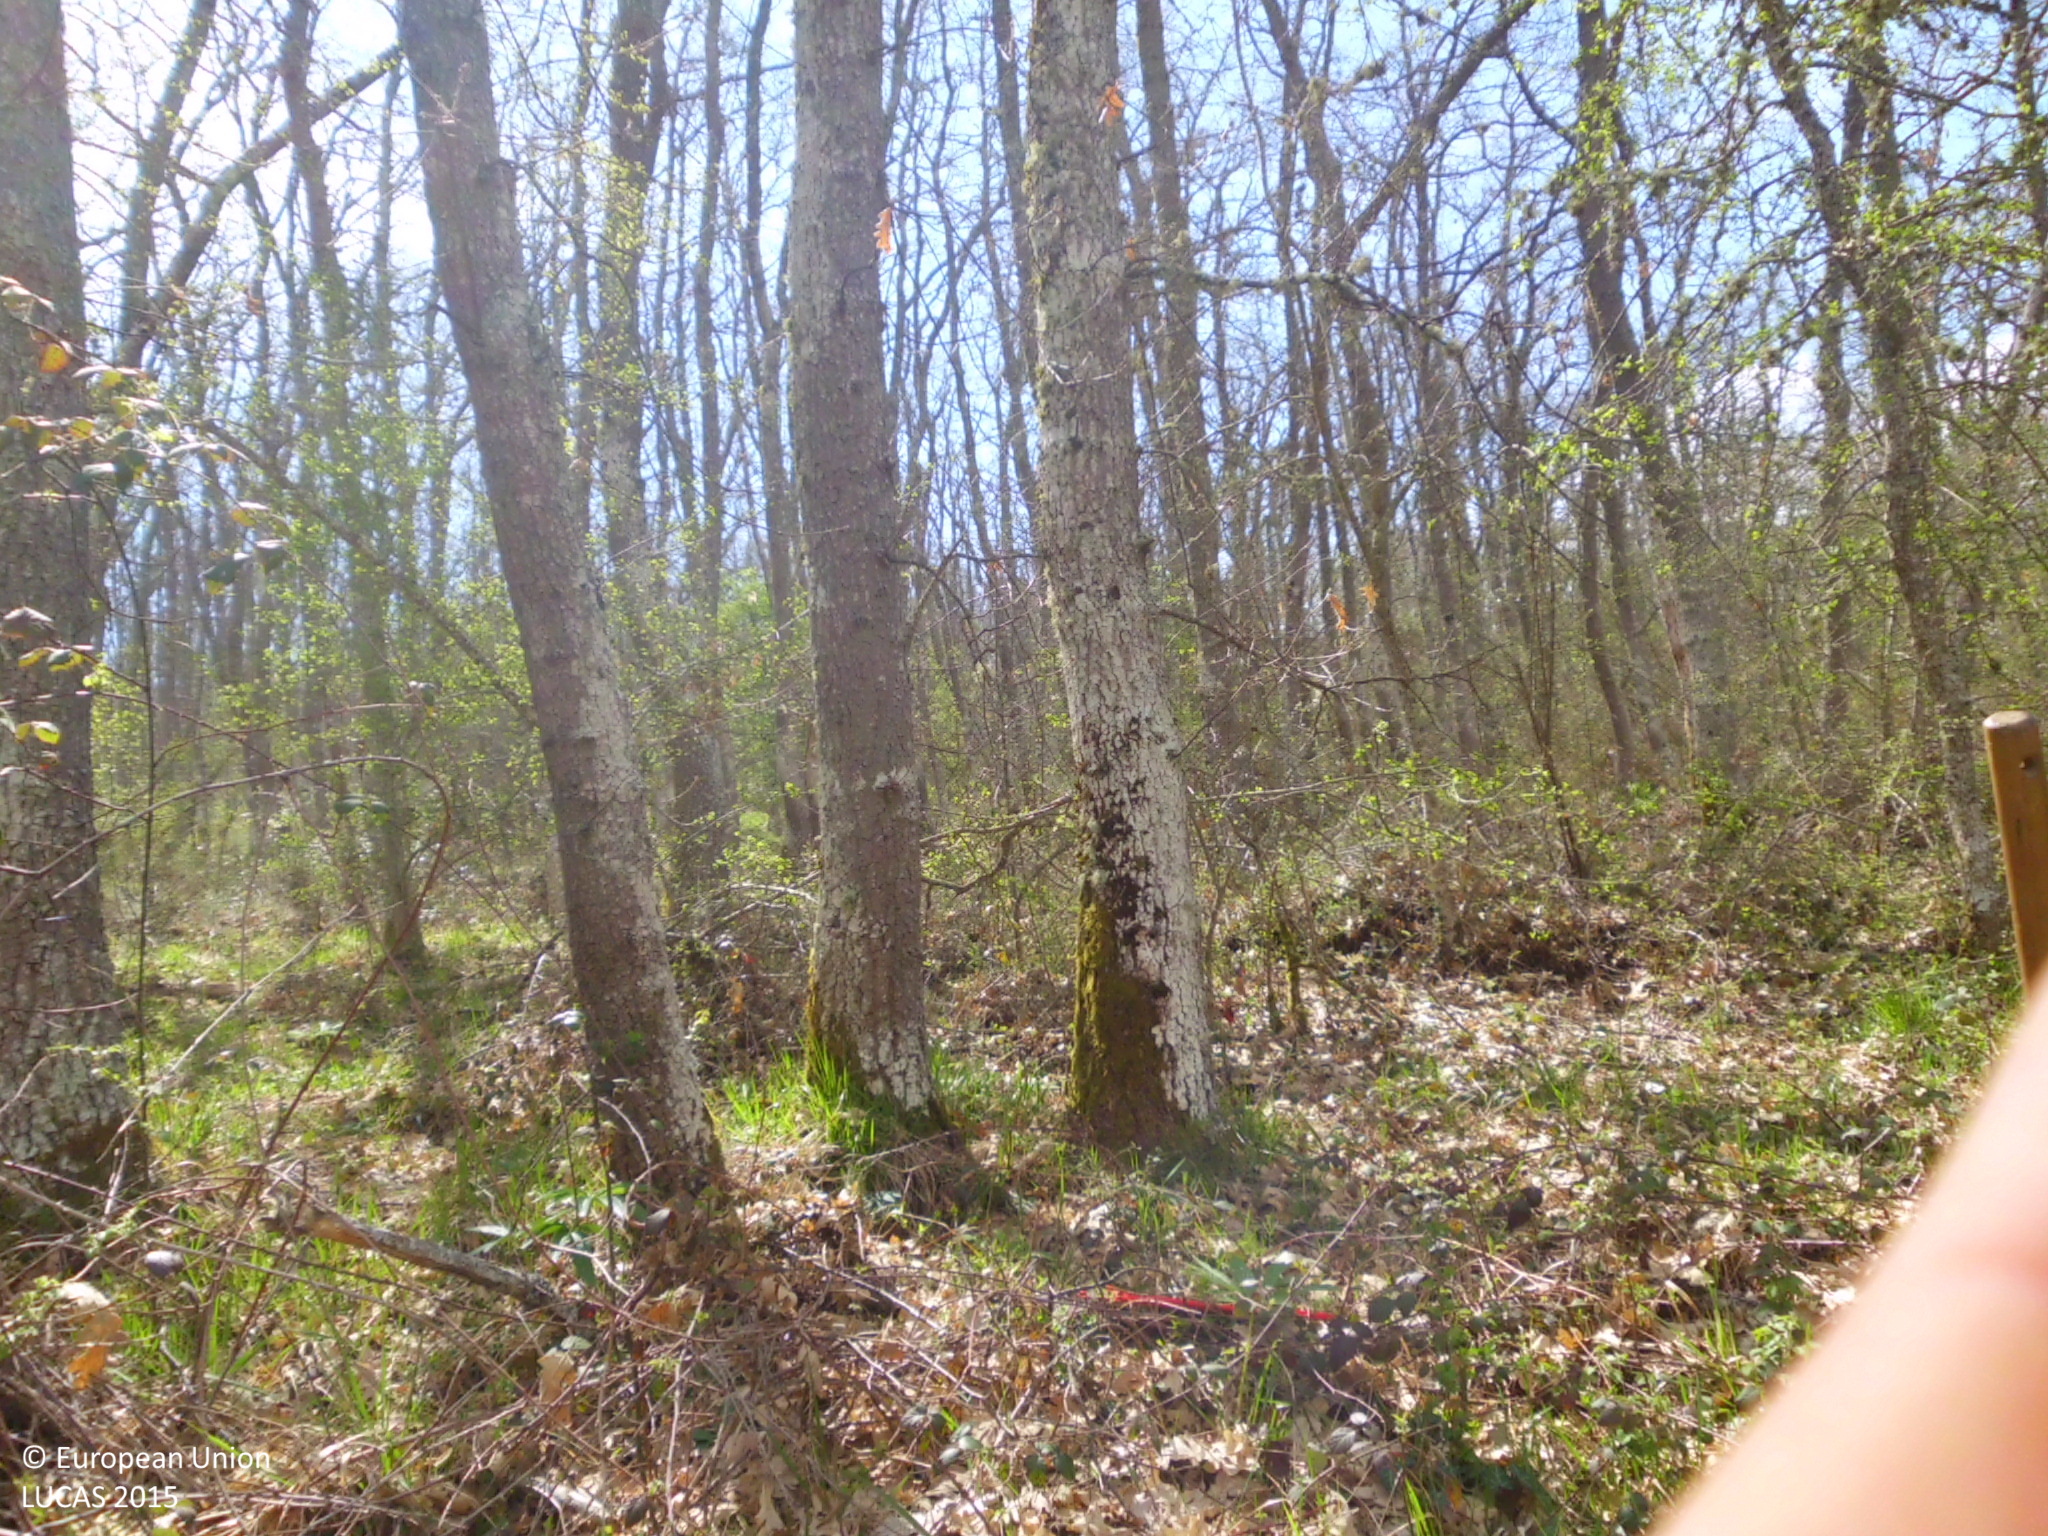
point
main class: Woodland
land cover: Broadleaved woodland
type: acidophilous oak and oak-birch forest
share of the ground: > 75 %
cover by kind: broadleaved forest trees 95 %, herbaceous plants 5 %
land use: Semi-natural and natural areas not in use
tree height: > 5 m
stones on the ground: < 10 %
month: April
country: ES
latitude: 42.4010
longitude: -3.3844
